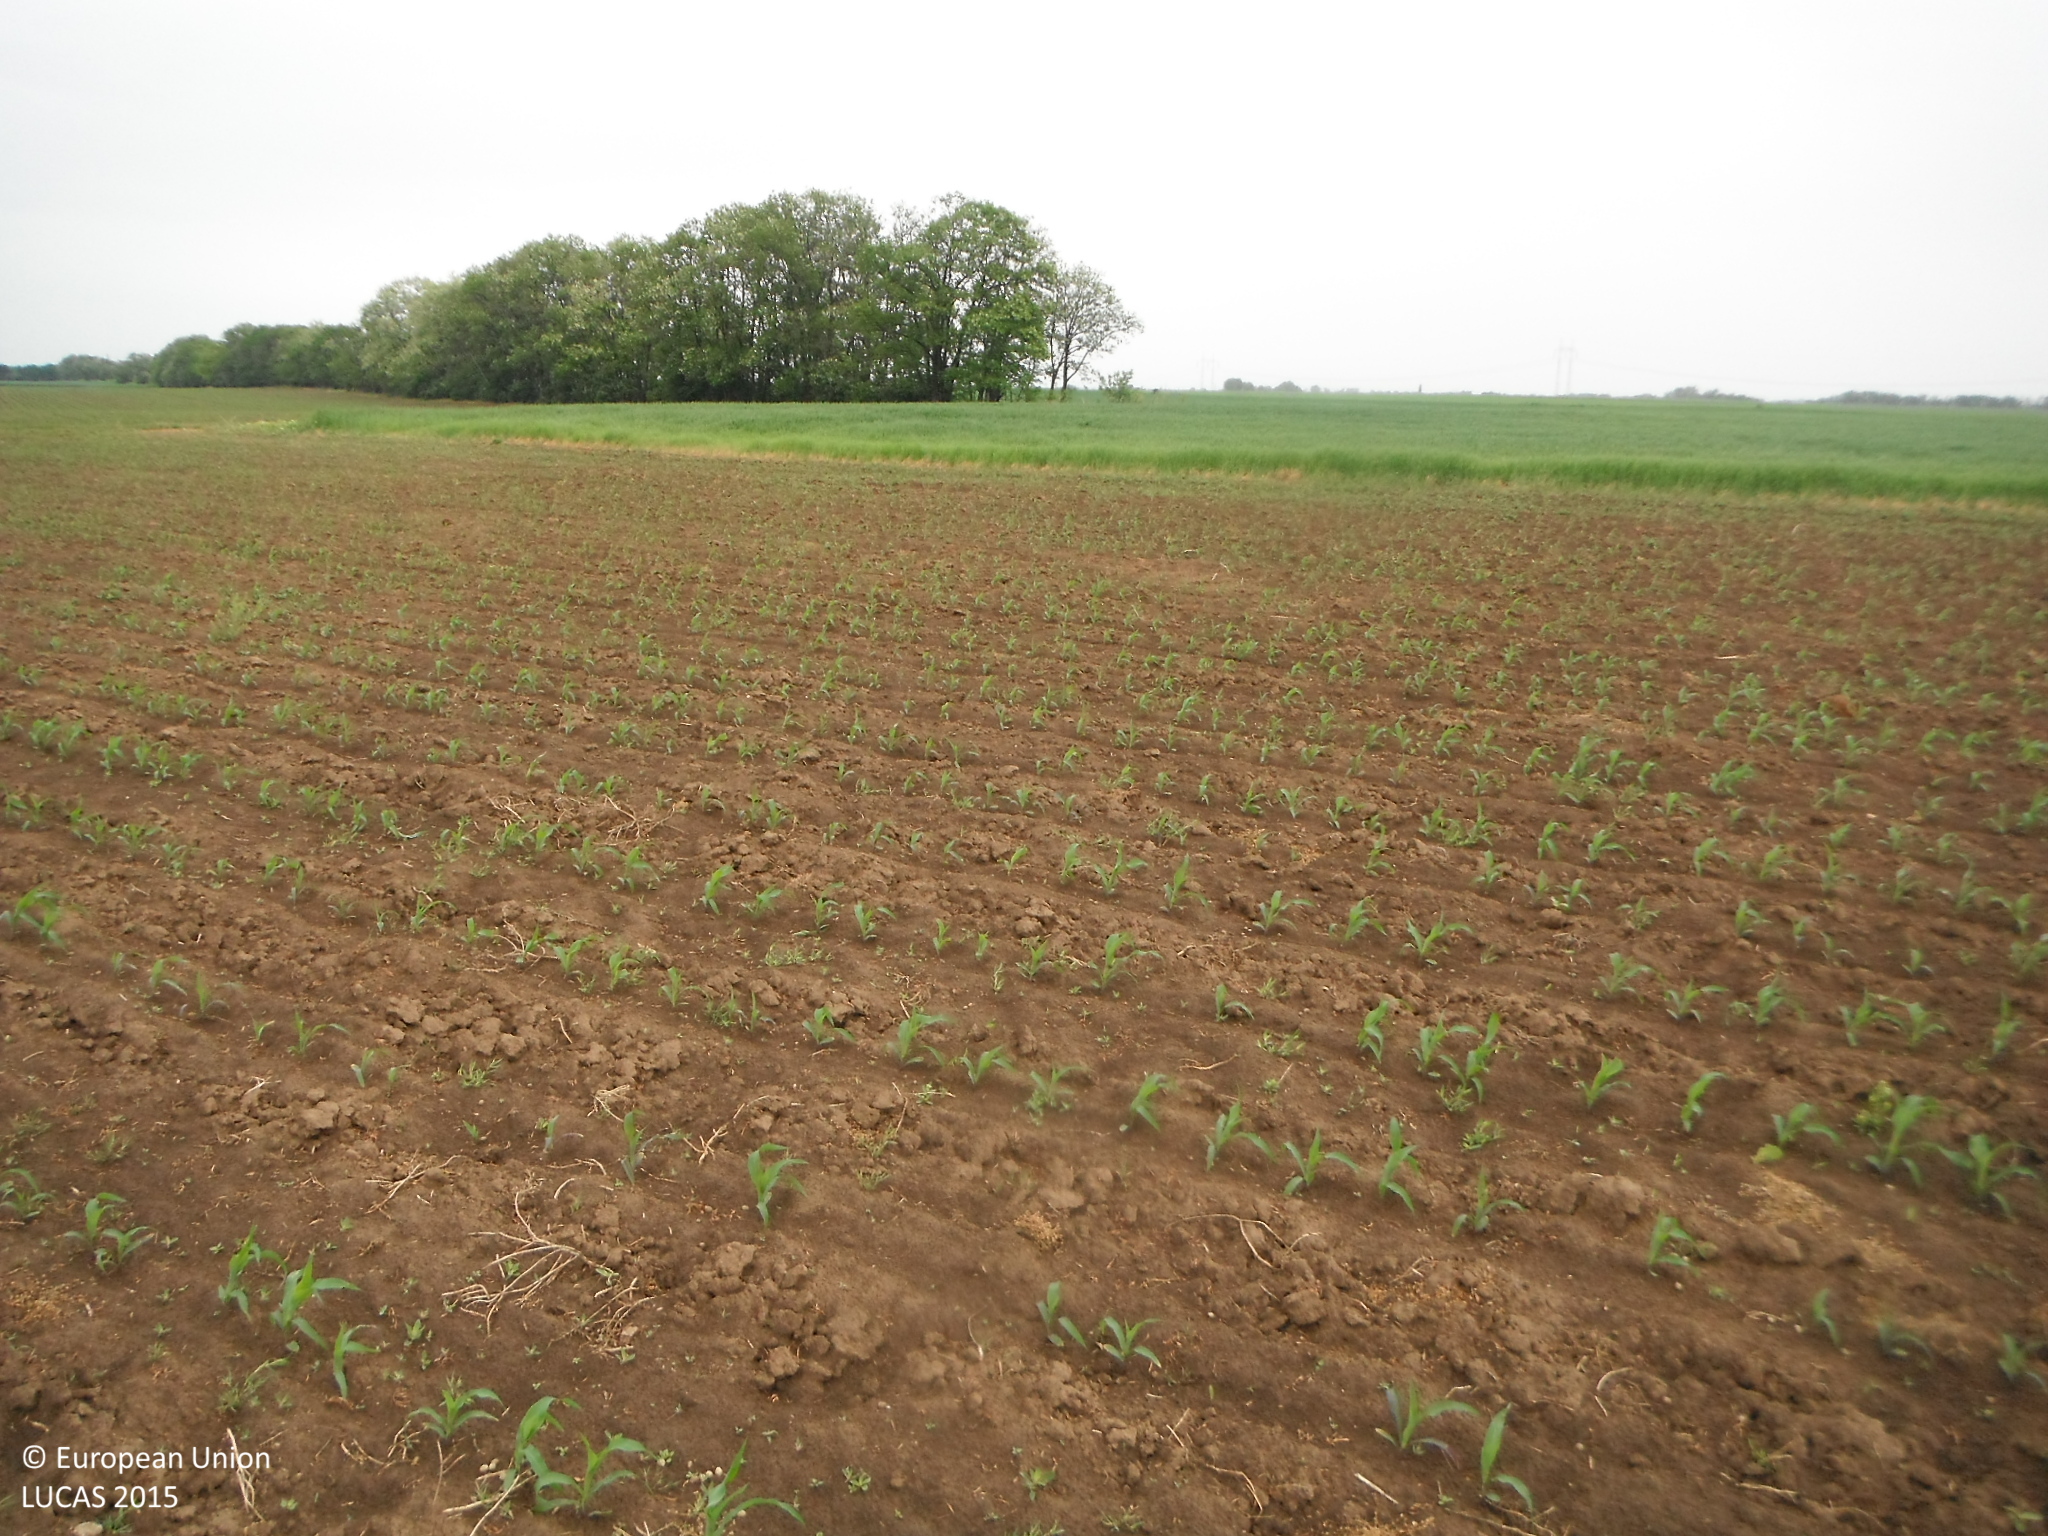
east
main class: Cropland
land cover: Maize
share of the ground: 10 - 25 %
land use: Agriculture (excluding fallow land and kitchen gardens)
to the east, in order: Maize; Common wheat; Grass margins; Tracks; Grass margins; Maize; Broadleaved woodland; Tracks; Broadleaved woodland; Common wheat
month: May
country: SK
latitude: 48.2685
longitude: 17.5957
